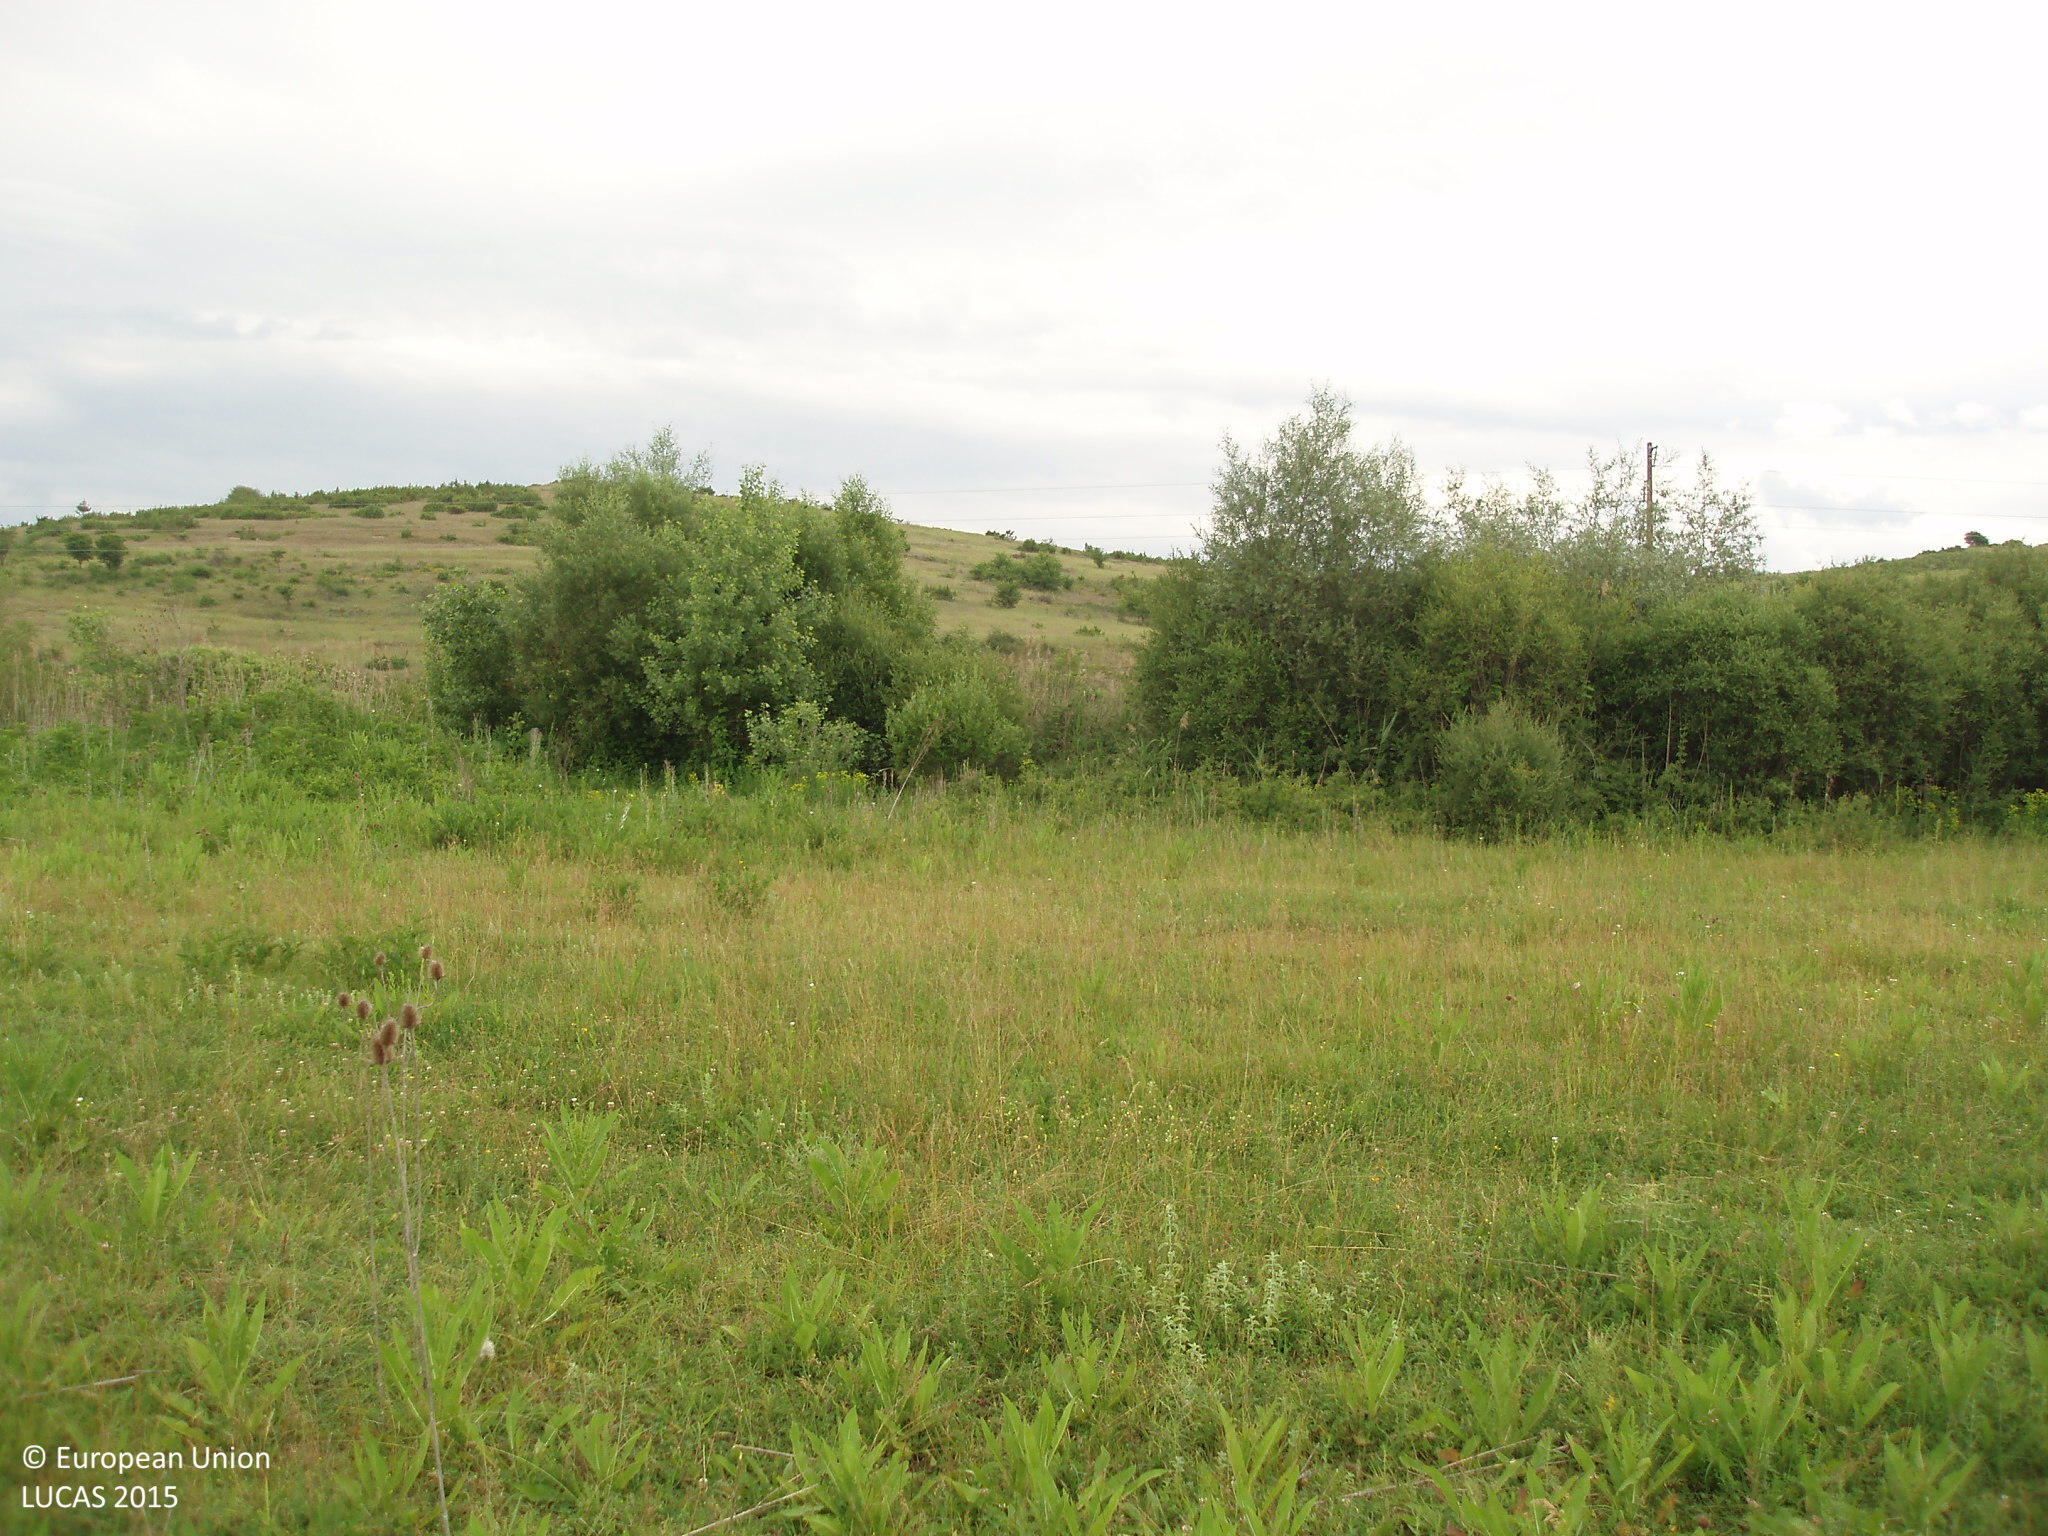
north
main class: Grassland
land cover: Grassland without tree/shrub cover
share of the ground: > 75 %
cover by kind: herbaceous plants 100 %
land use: Agriculture (excluding fallow land and kitchen gardens)
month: June
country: BG
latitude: 41.5184
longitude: 23.8212
